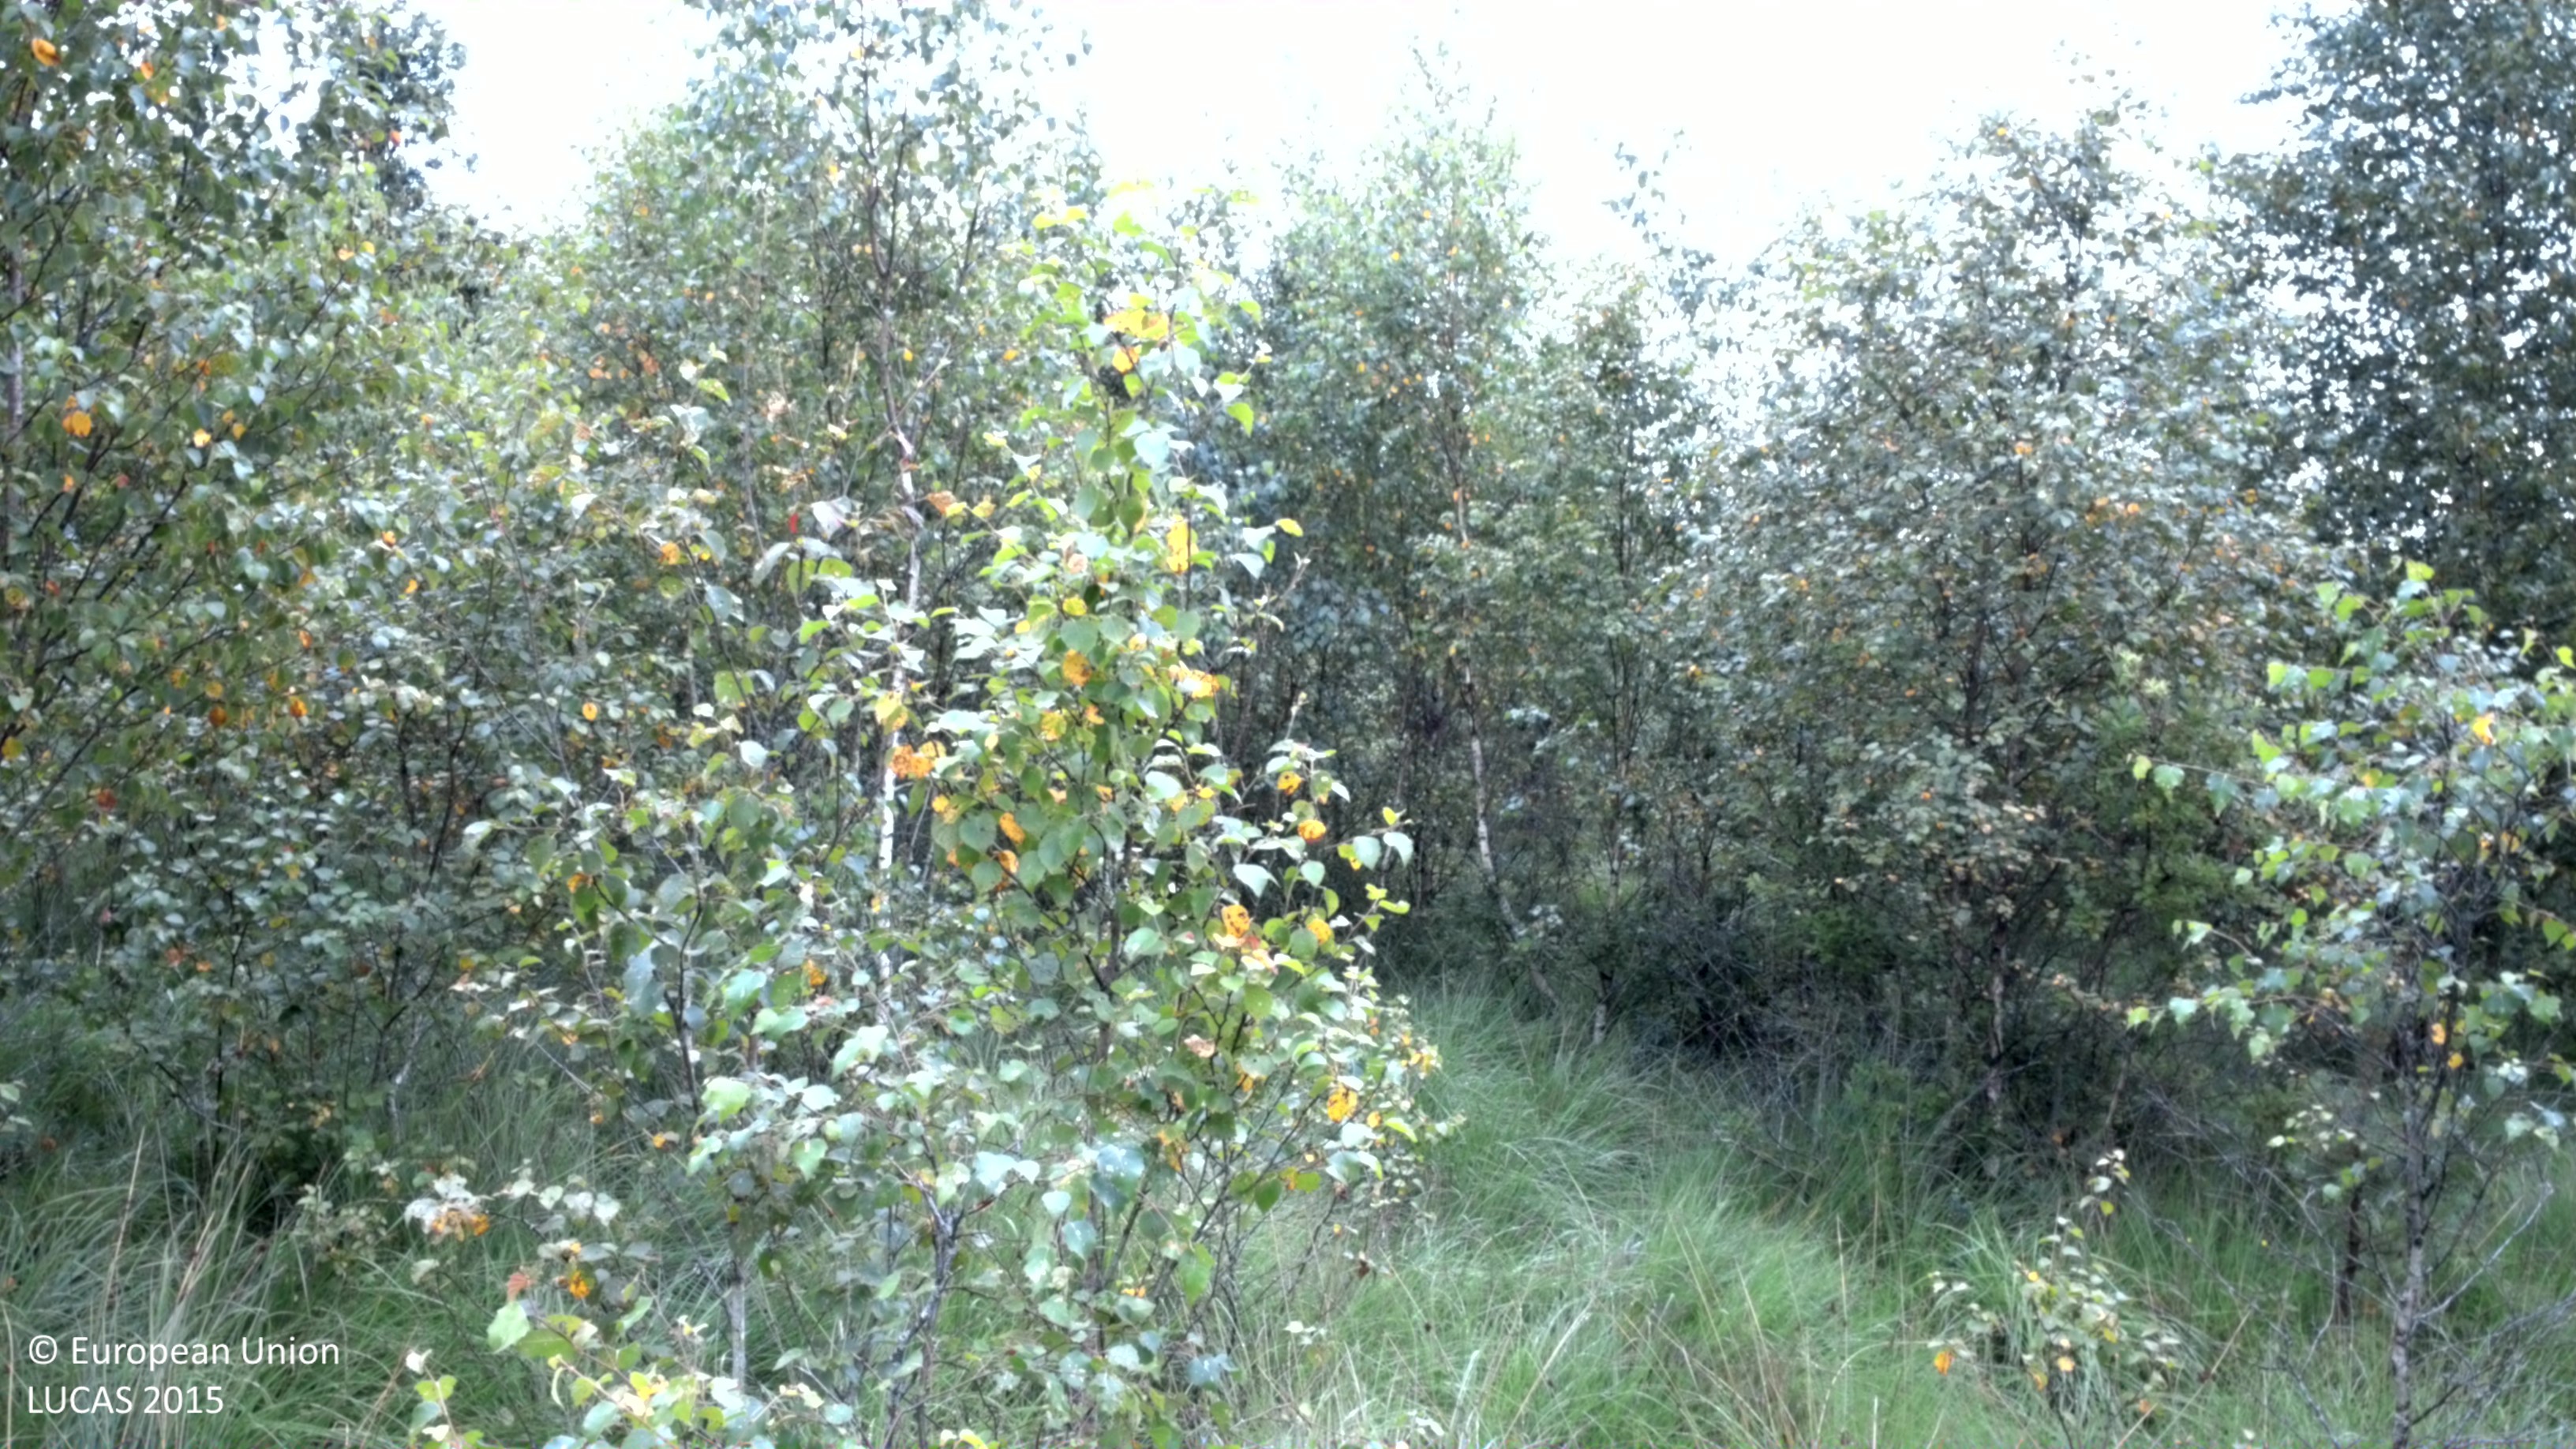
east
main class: Woodland
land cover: Spruce dominated mixed woodland
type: boreal forest
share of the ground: 50 - 75 %
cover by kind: broadleaved forest trees 45 %, herbaceous plants 35 %, coniferous forest trees 15 %, shrubs 5 %
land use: Forestry
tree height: < 5 m
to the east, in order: Spruce dominated mixed woodland; Broadleaved woodland; Spruce dominated mixed woodland
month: August
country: SE
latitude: 56.7424
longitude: 13.8389
